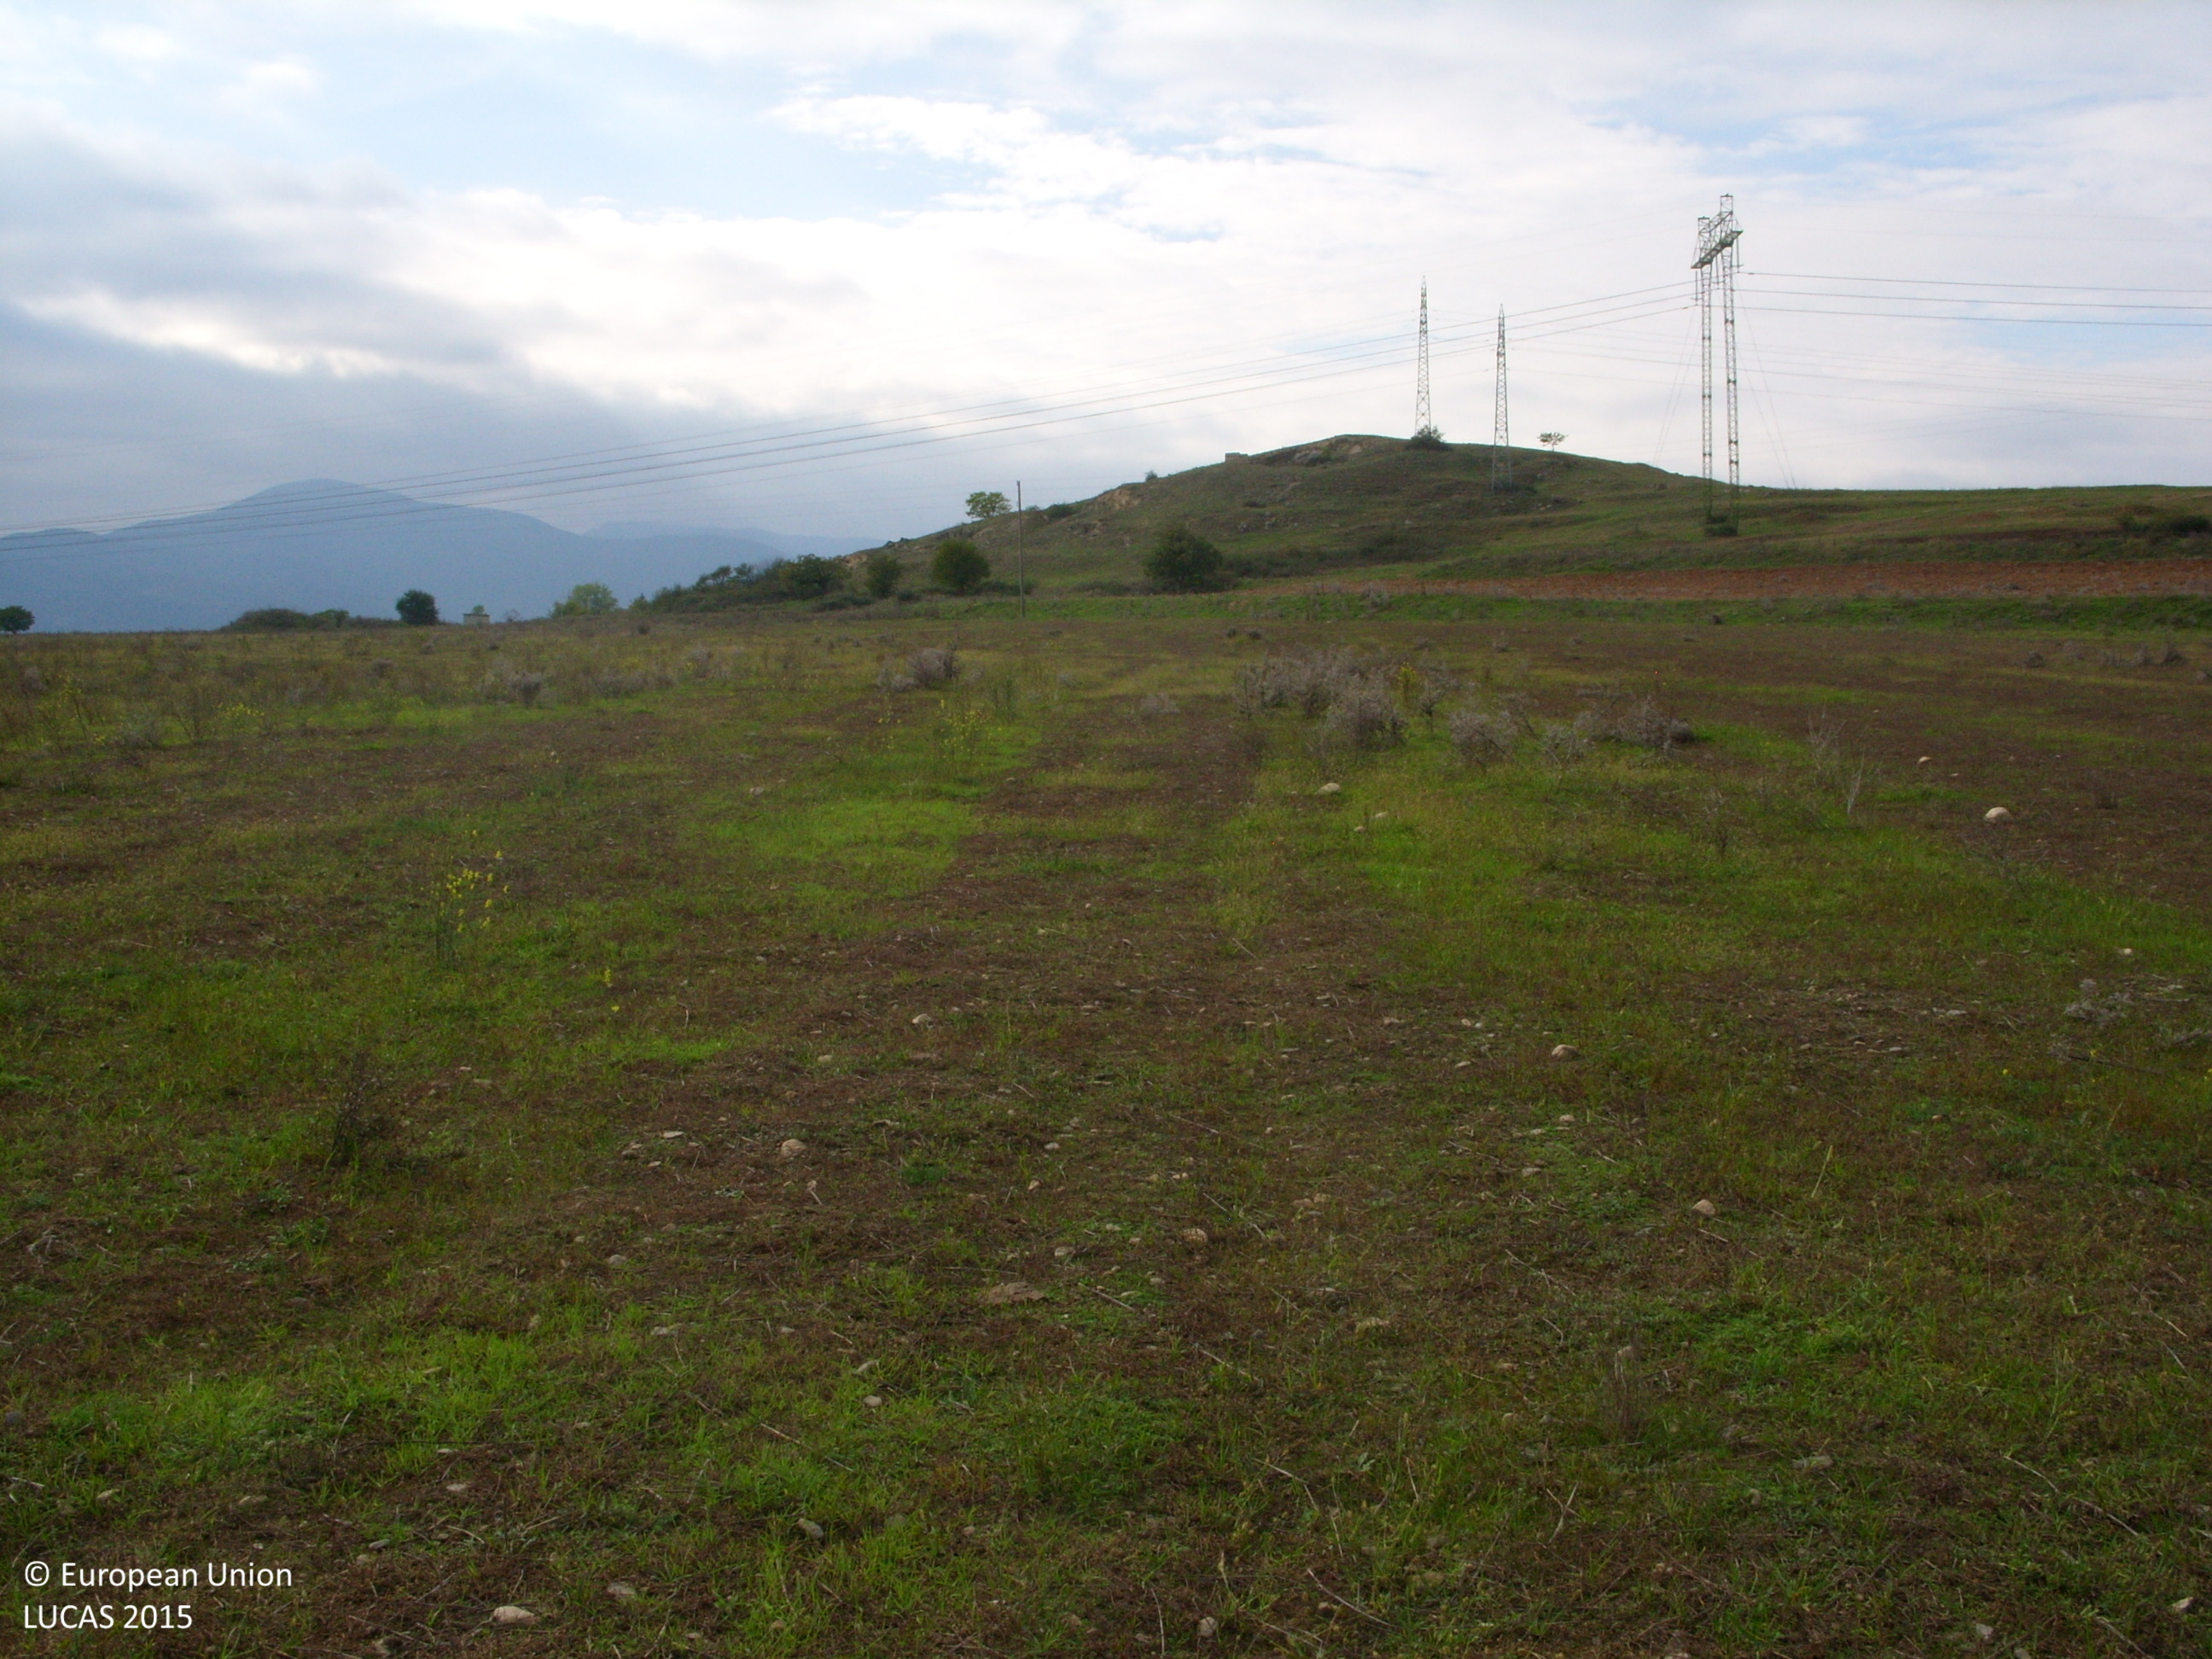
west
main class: Grassland
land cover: Spontaneously vegetated surfaces
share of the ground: > 75 %
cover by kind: herbaceous plants 90 %, unconsolidated bare surface 10 %
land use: Agriculture (excluding fallow land and kitchen gardens)
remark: Harvested field
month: October
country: BG
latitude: 42.5842
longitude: 24.8136
